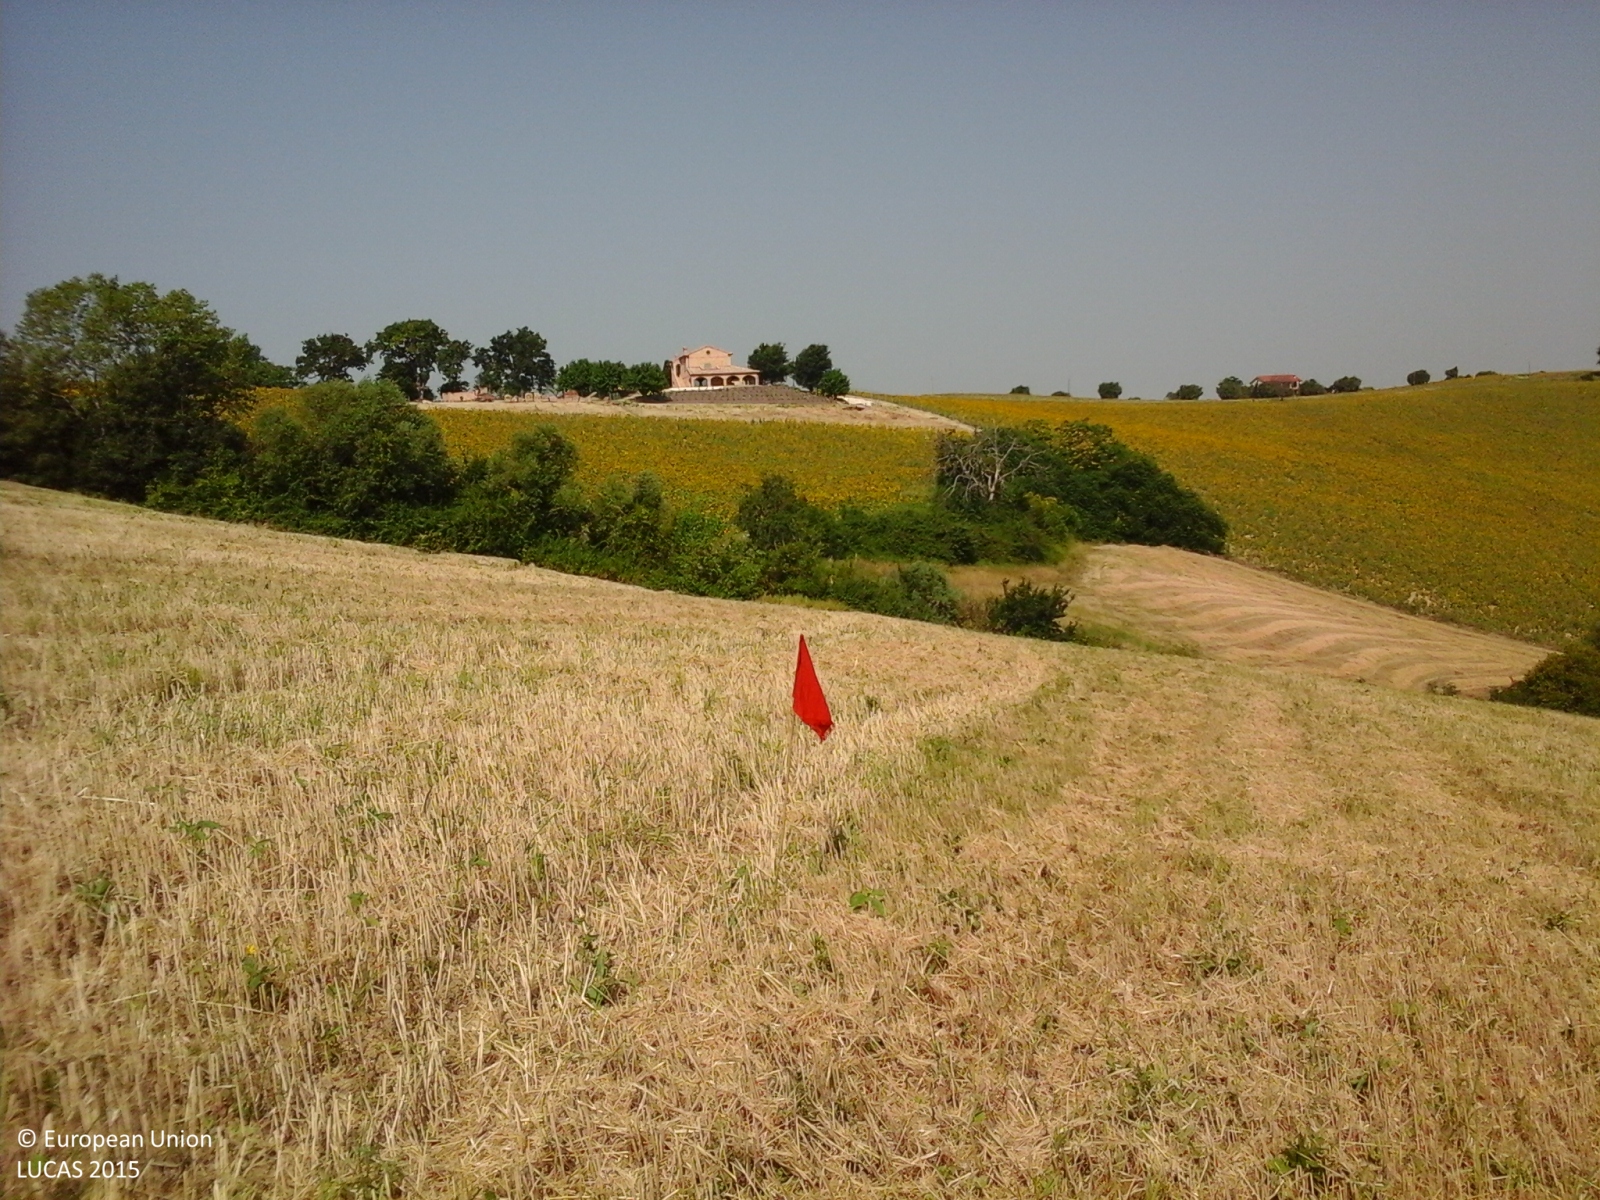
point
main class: Cropland
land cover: Durum wheat
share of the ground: > 75 %
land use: Agriculture (excluding fallow land and kitchen gardens)
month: July
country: IT
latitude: 43.4064
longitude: 13.5106
